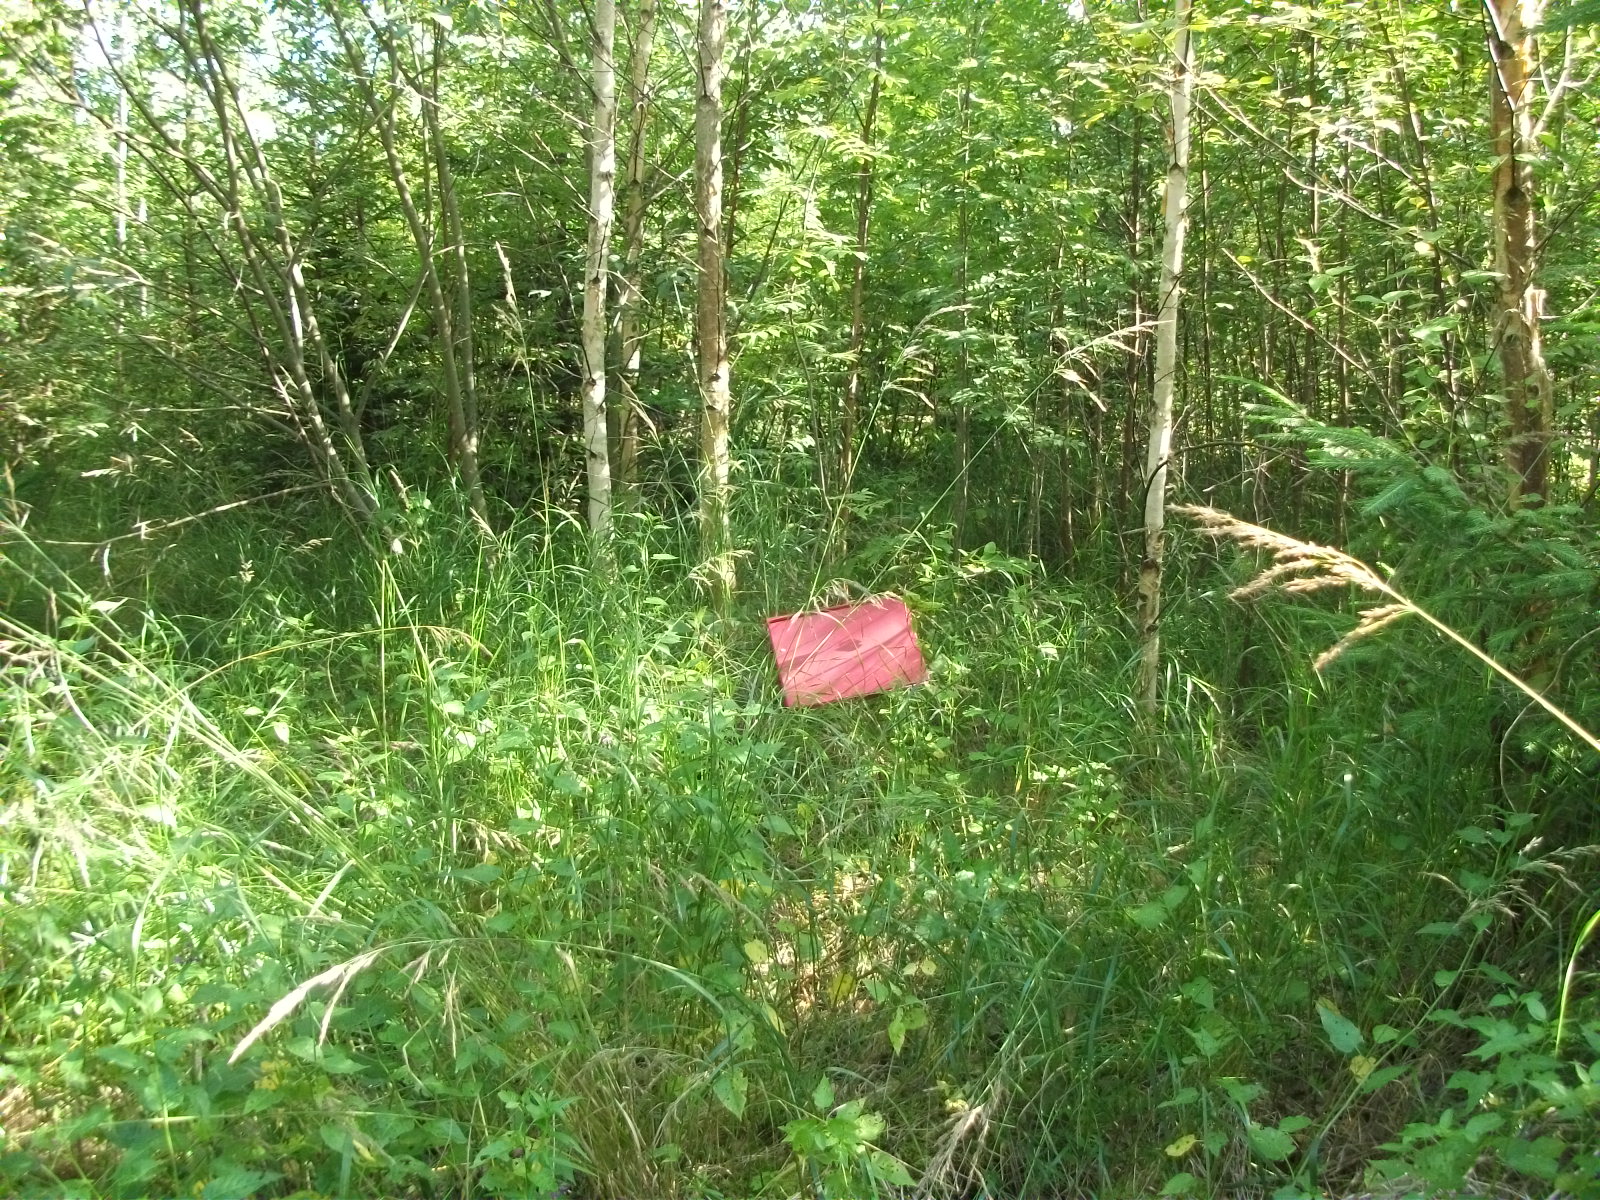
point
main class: Woodland
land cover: Broadleaved woodland
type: non-riverine alder, birch or aspen forest
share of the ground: > 75 %
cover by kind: broadleaved forest trees 85 %, coniferous forest trees 5 %, shrubs 5 %, herbaceous plants 5 %
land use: Forestry
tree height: > 5 m
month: August
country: LV
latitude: 57.0664
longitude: 26.5903
